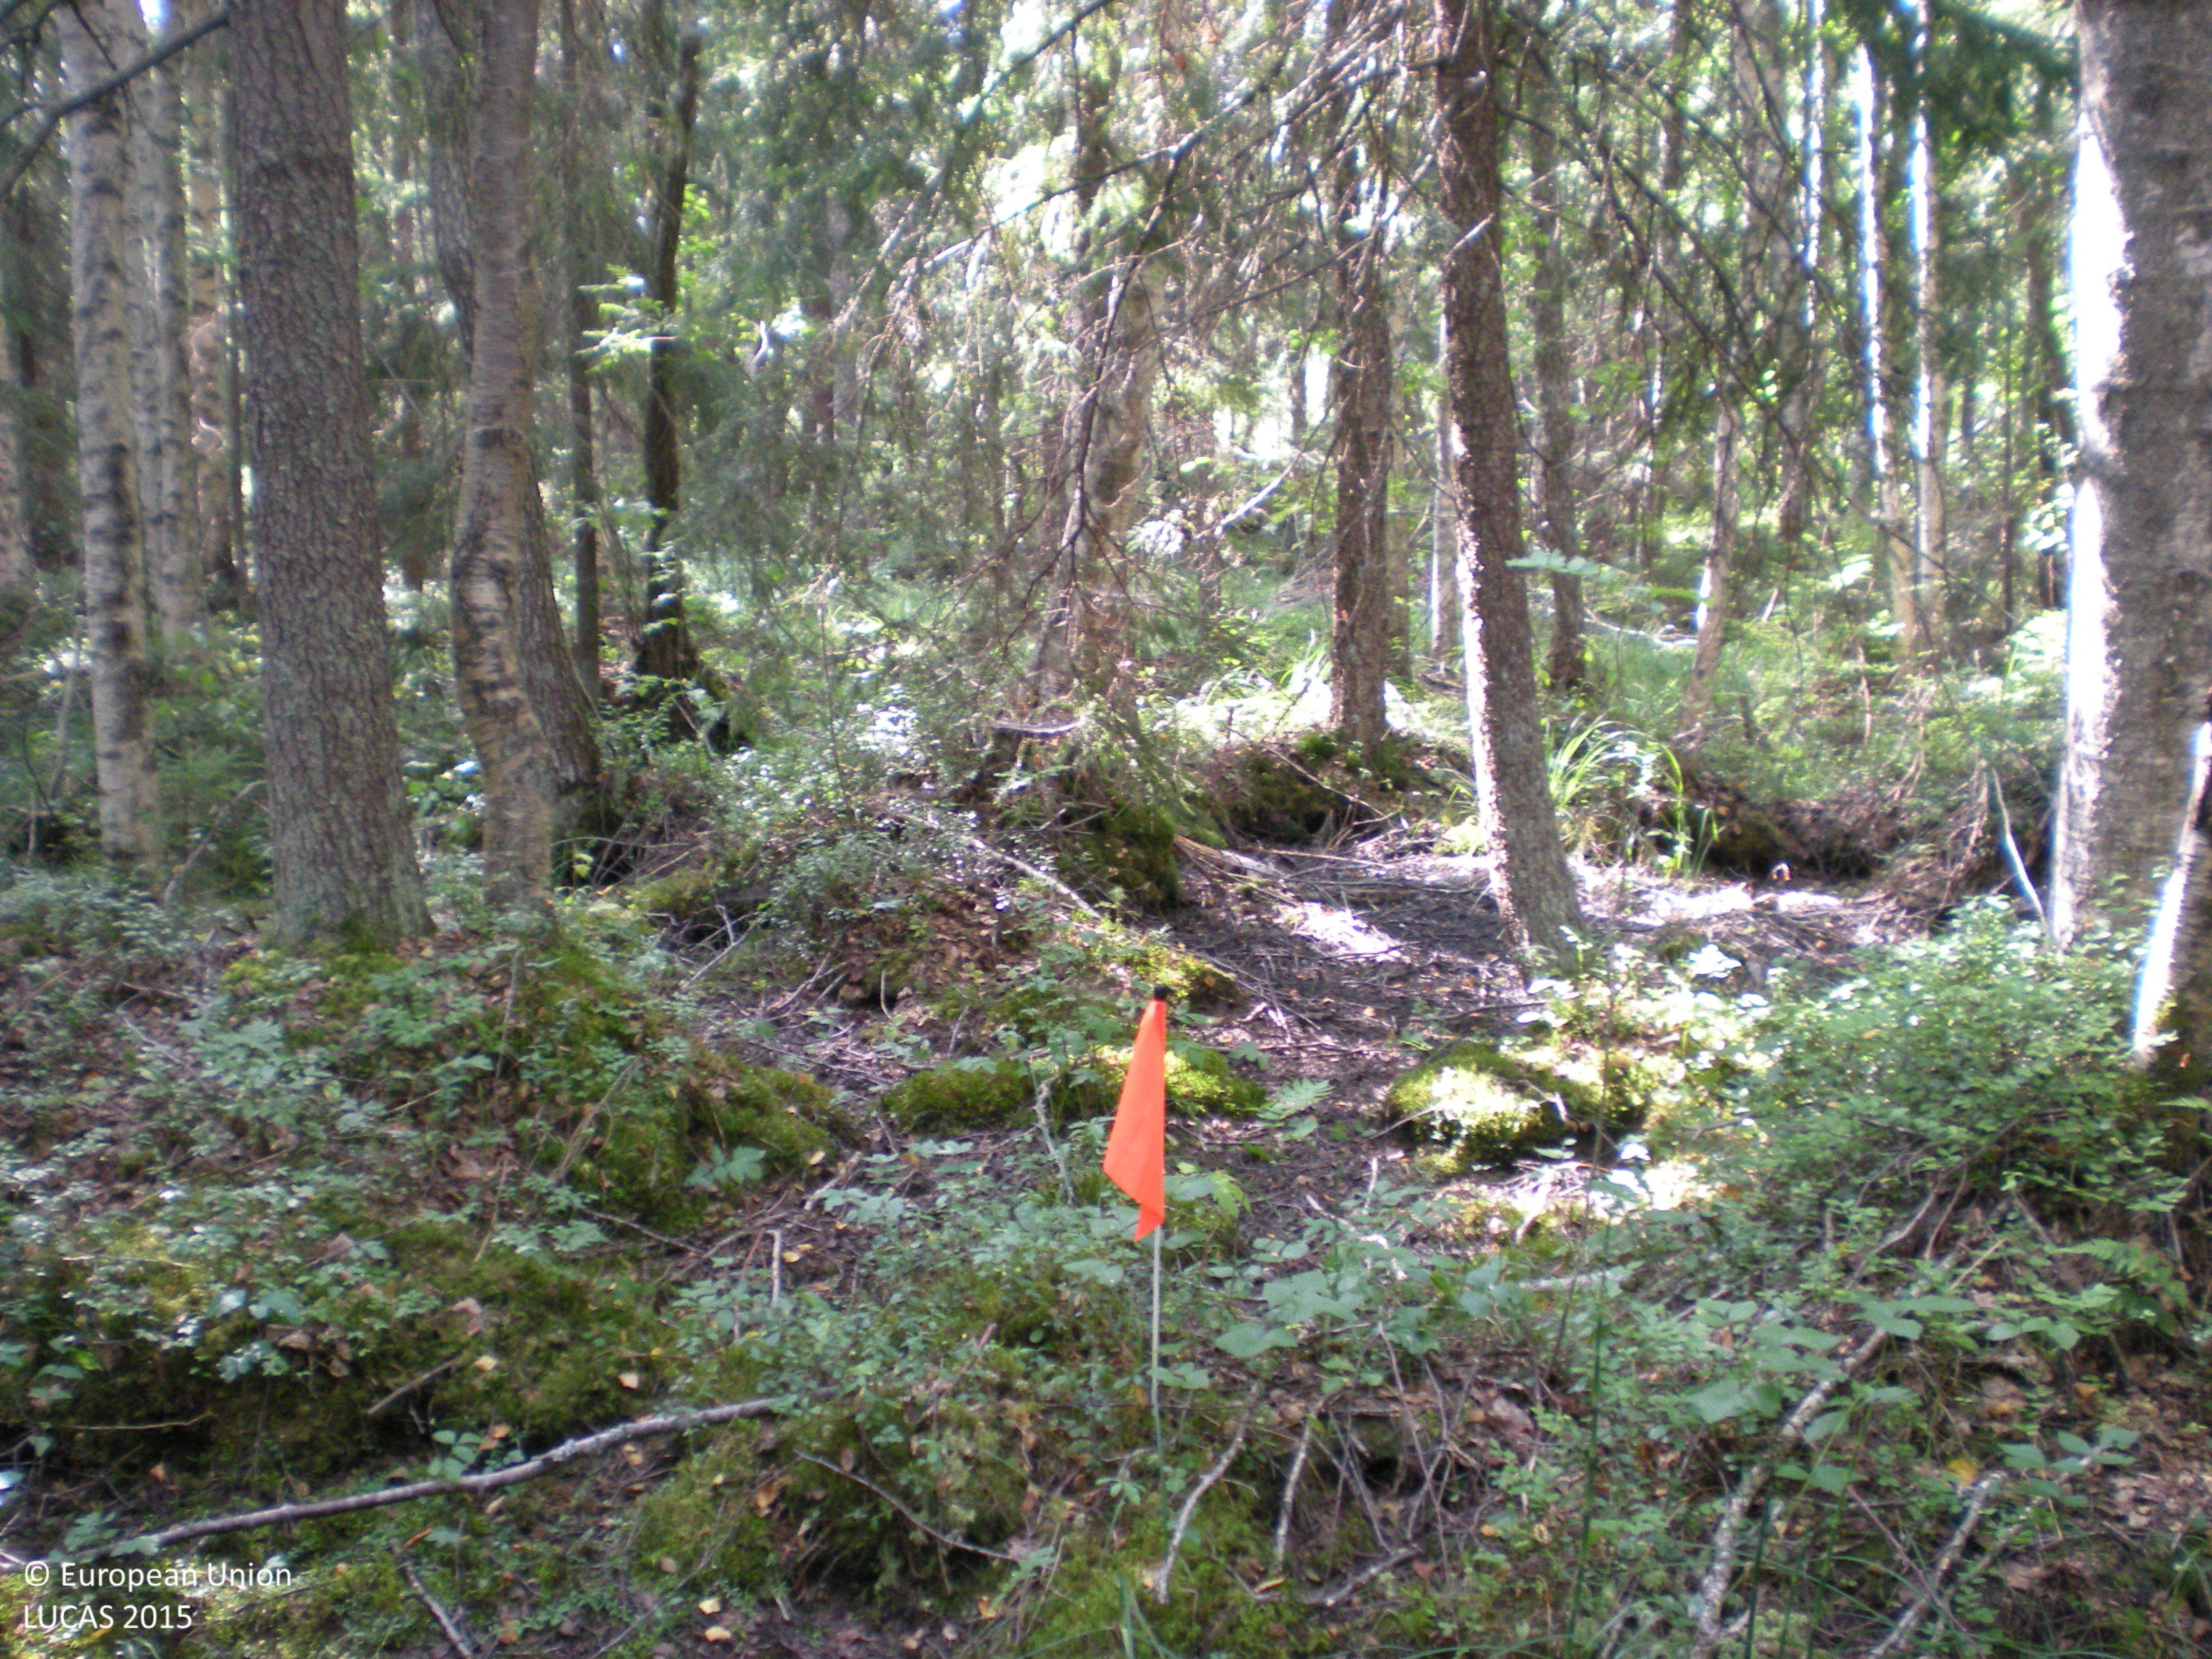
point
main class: Woodland
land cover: Spruce dominated mixed woodland
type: boreal forest
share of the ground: 50 - 75 %
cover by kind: coniferous forest trees 50 %, broadleaved forest trees 20 %, herbaceous plants 20 %, shrubs 5 %, lichens and mosses 5 %
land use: Forestry
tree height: > 5 m
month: August
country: SE
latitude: 60.6633
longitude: 17.2535
